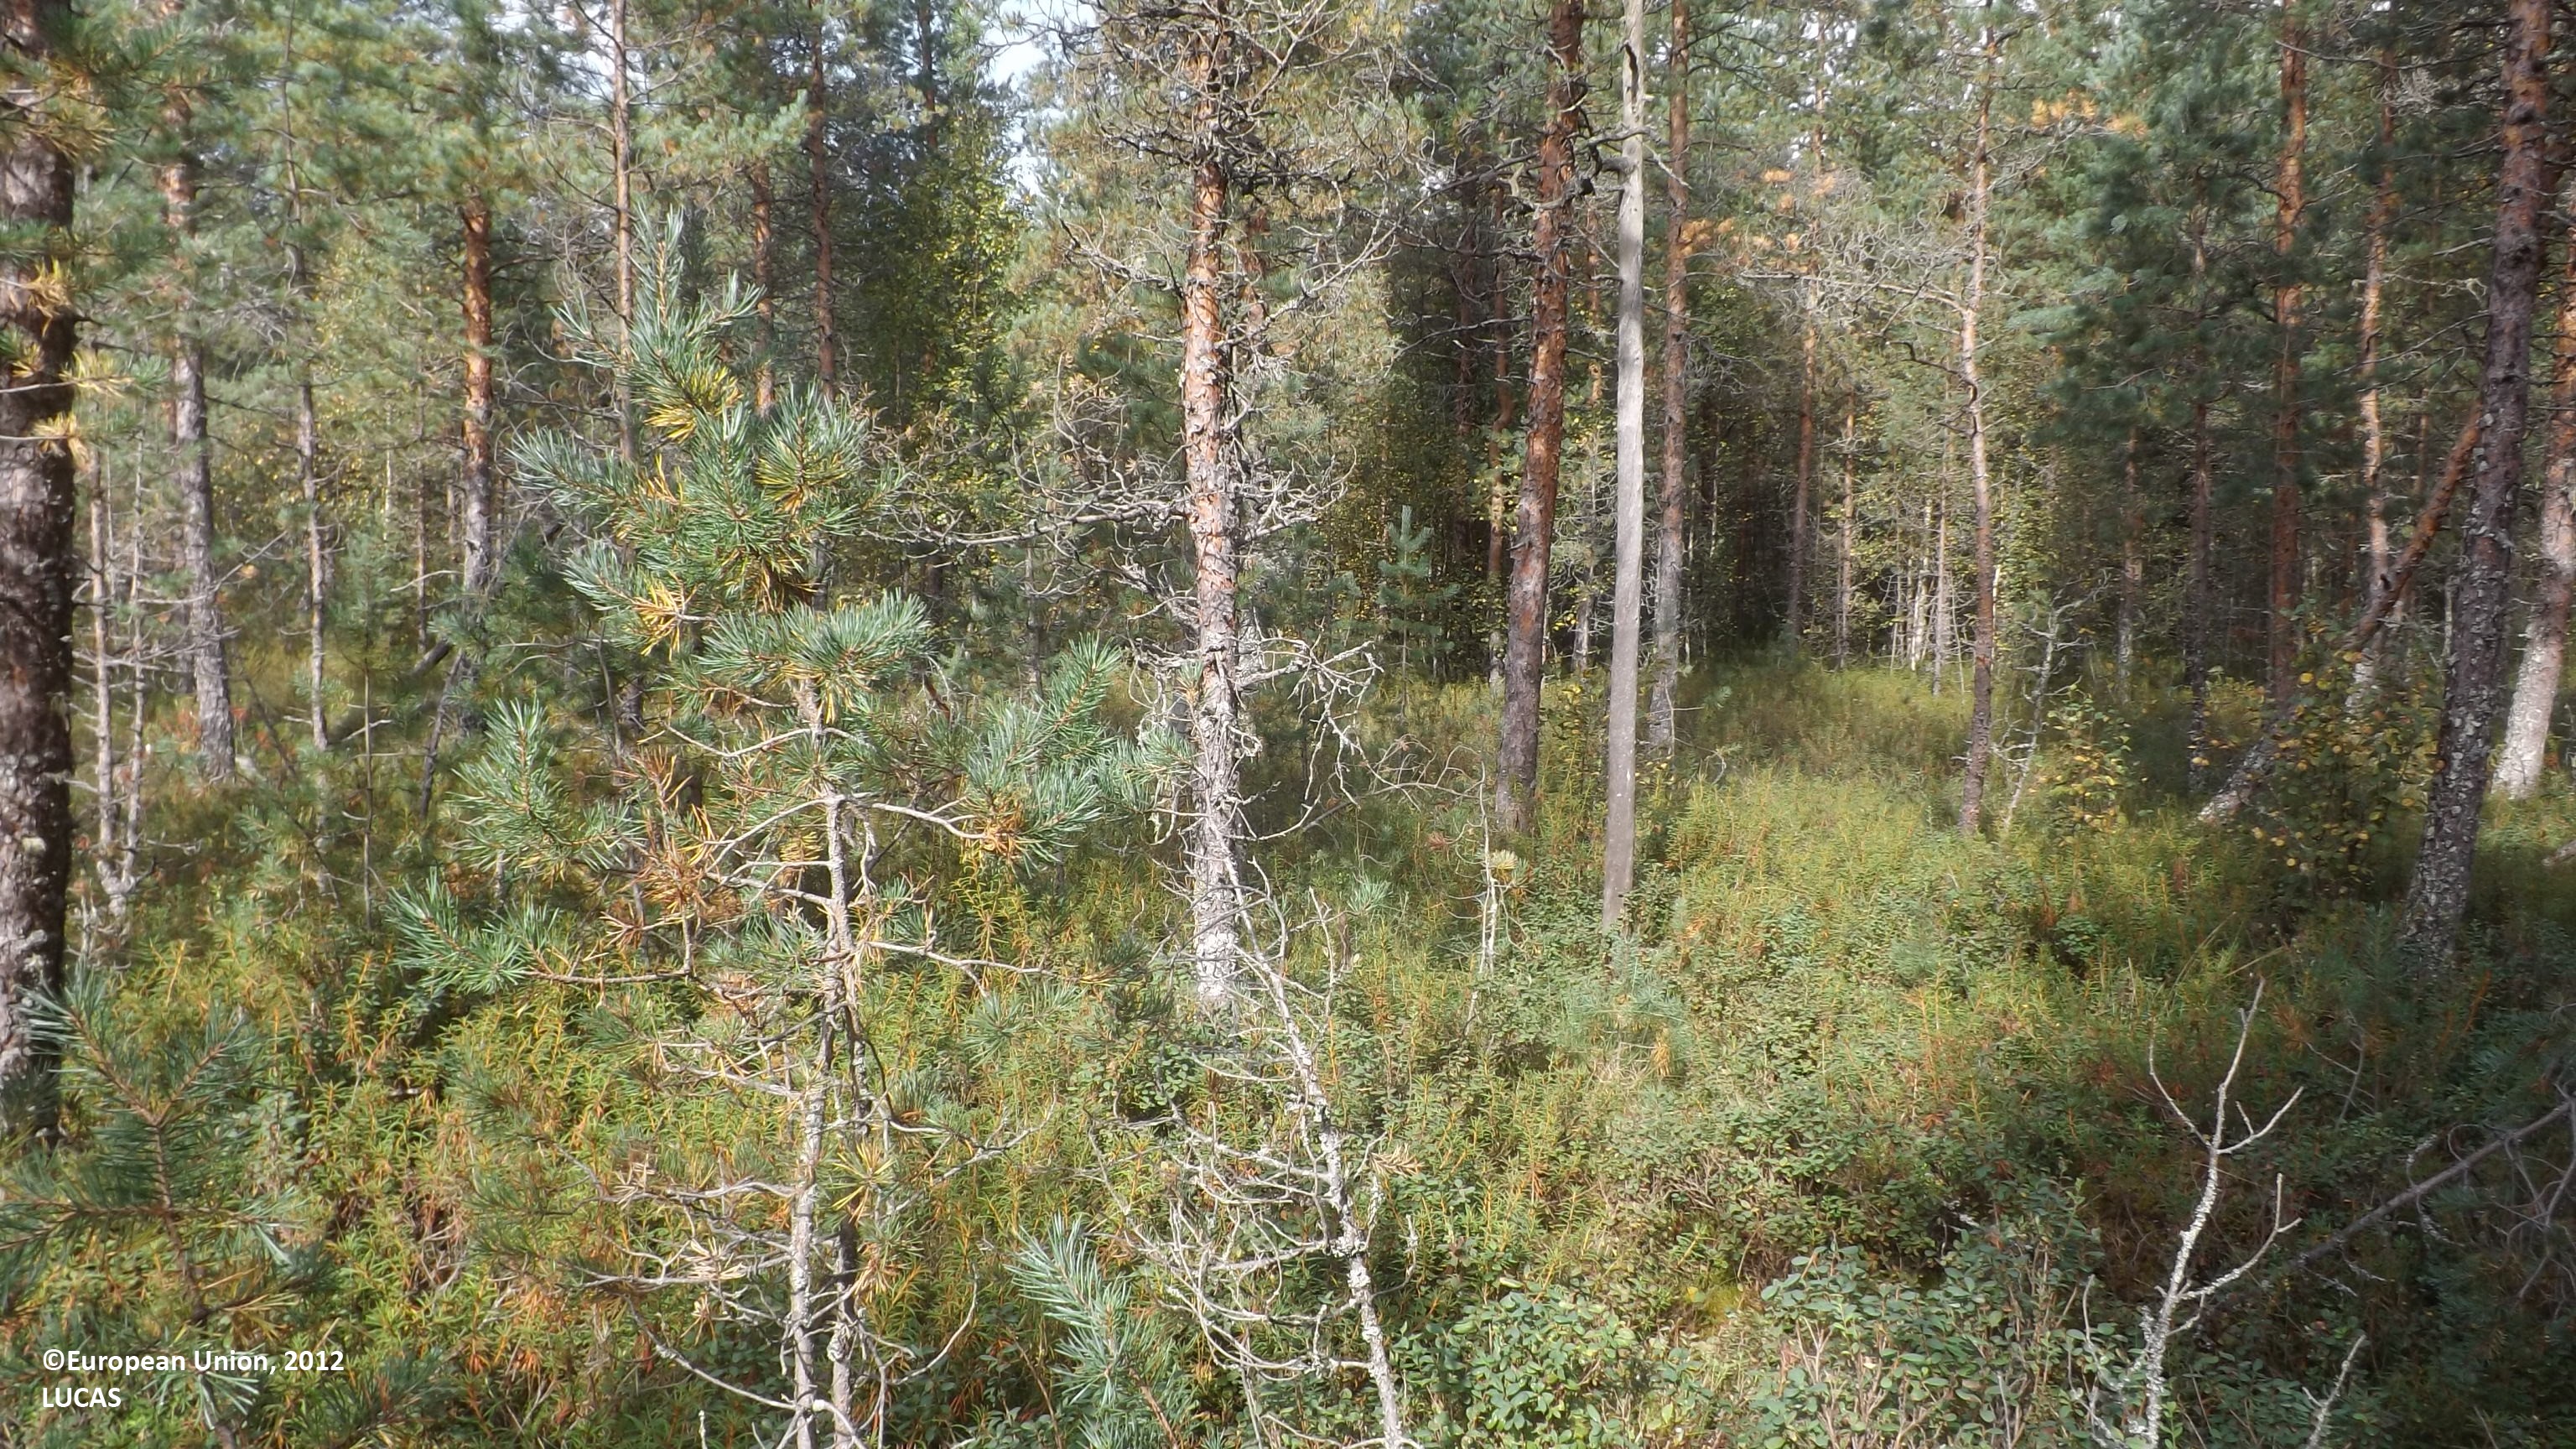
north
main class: Woodland
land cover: Pine dominated coniferous woodland
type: mire and swamp forests
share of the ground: 50 - 75 %
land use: Forestry
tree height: < 5 m
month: August
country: FI
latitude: 63.8935
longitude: 23.6876
